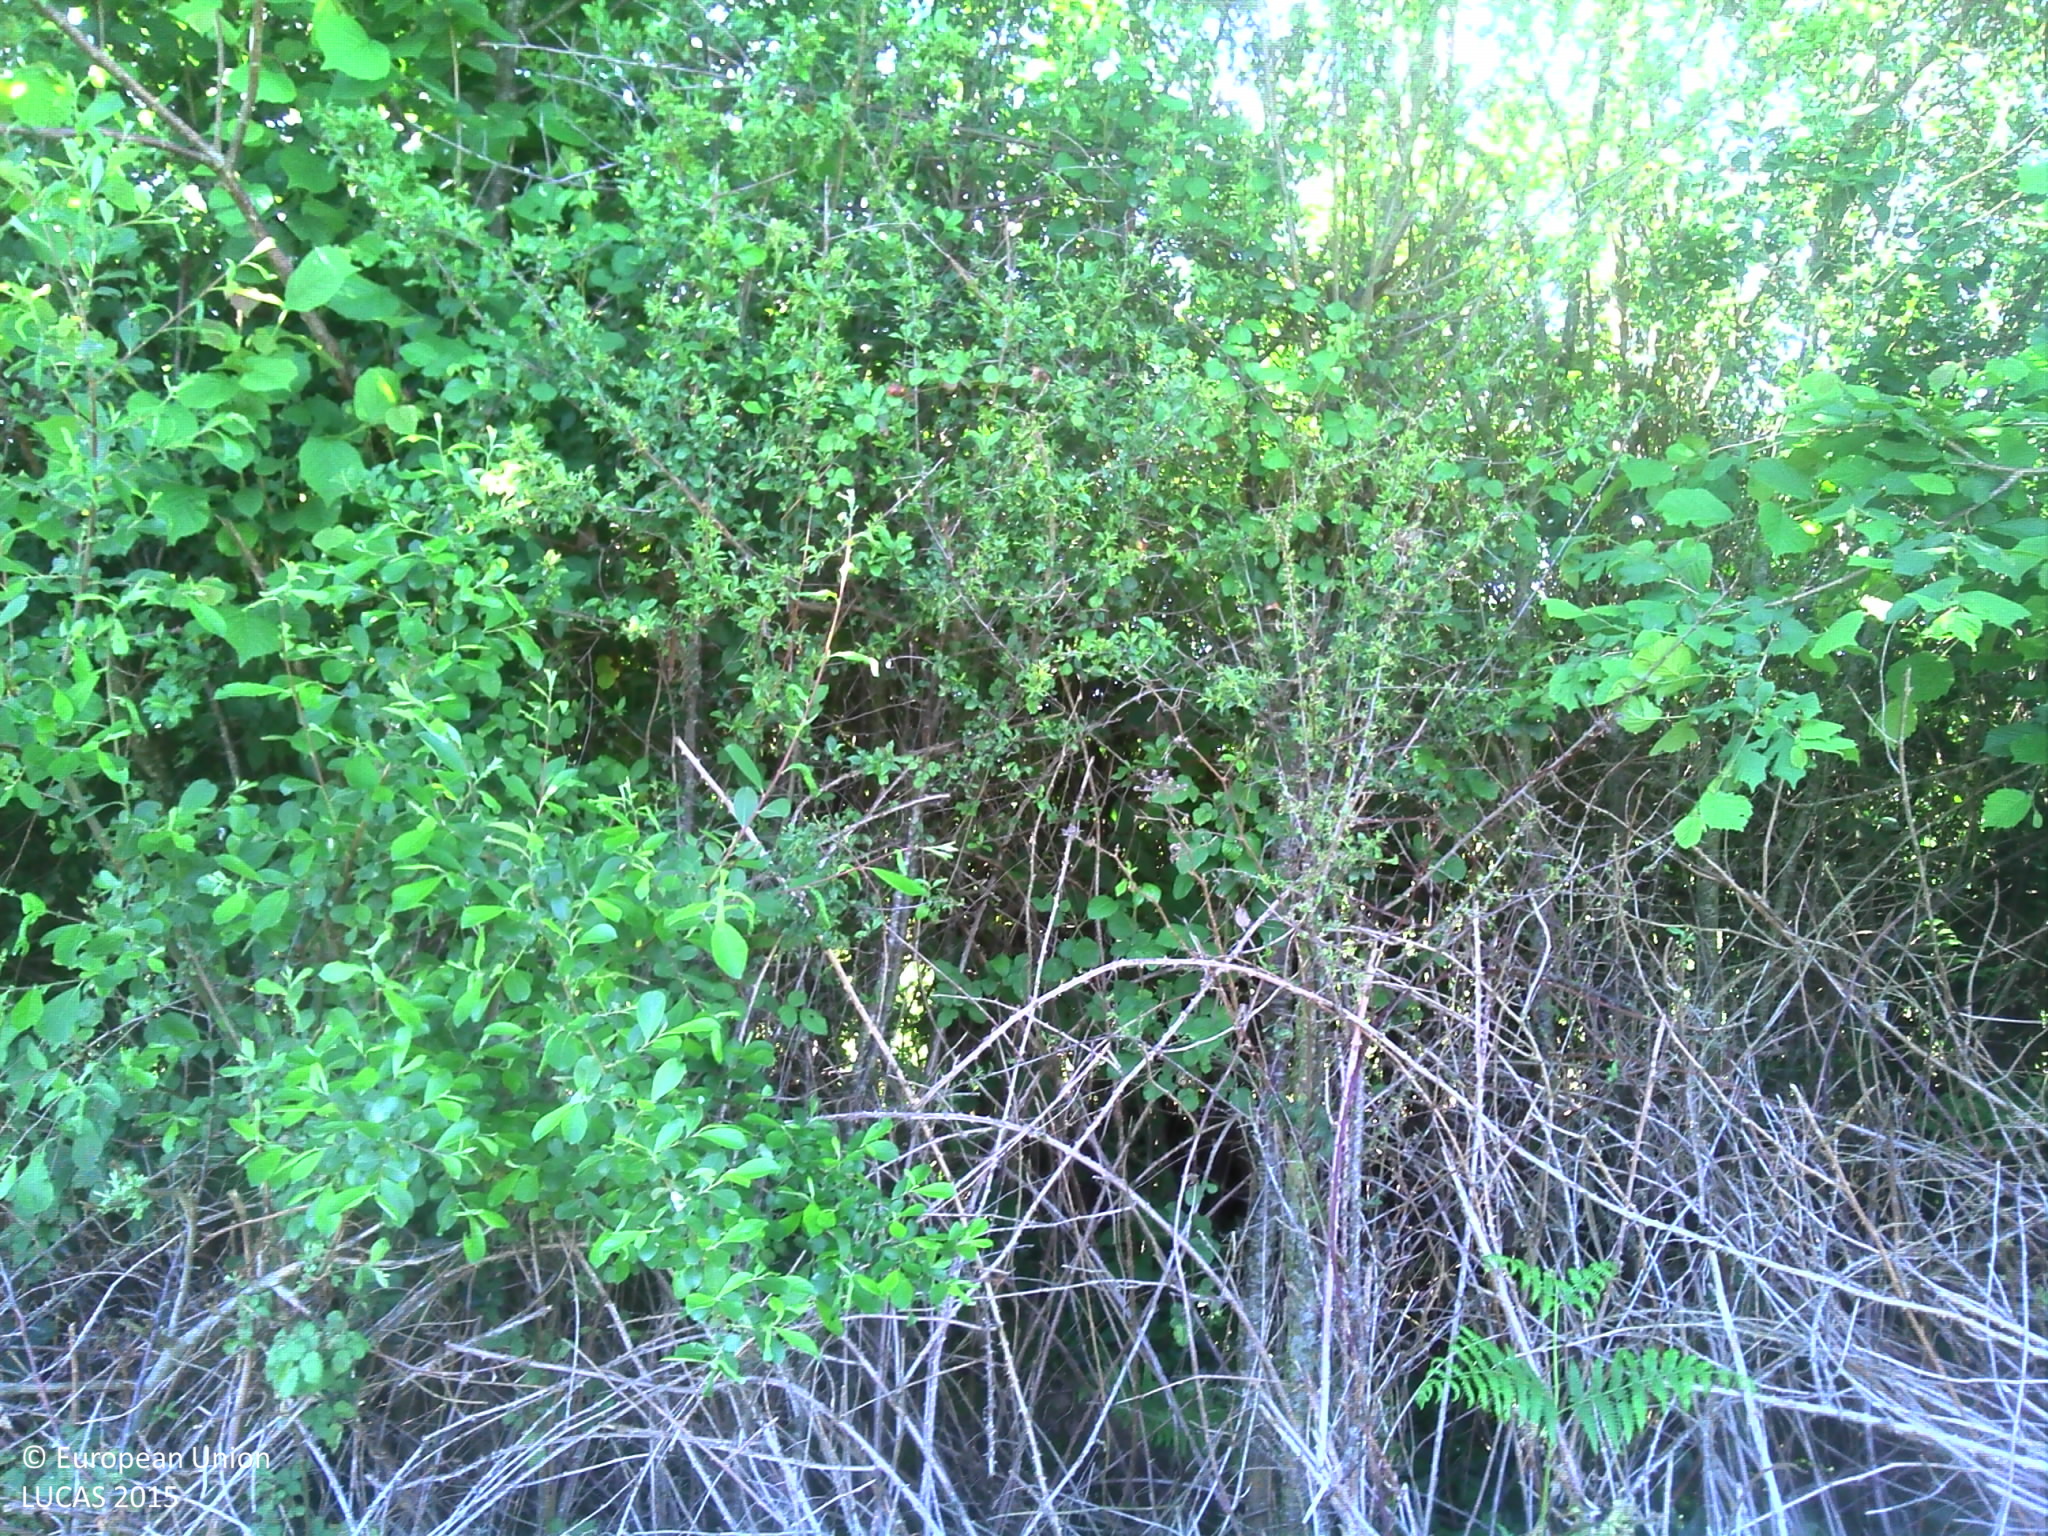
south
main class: Cropland
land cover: Triticale
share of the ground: > 75 %
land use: Agriculture (excluding fallow land and kitchen gardens)
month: June
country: FR
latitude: 46.4014
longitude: 2.3336
